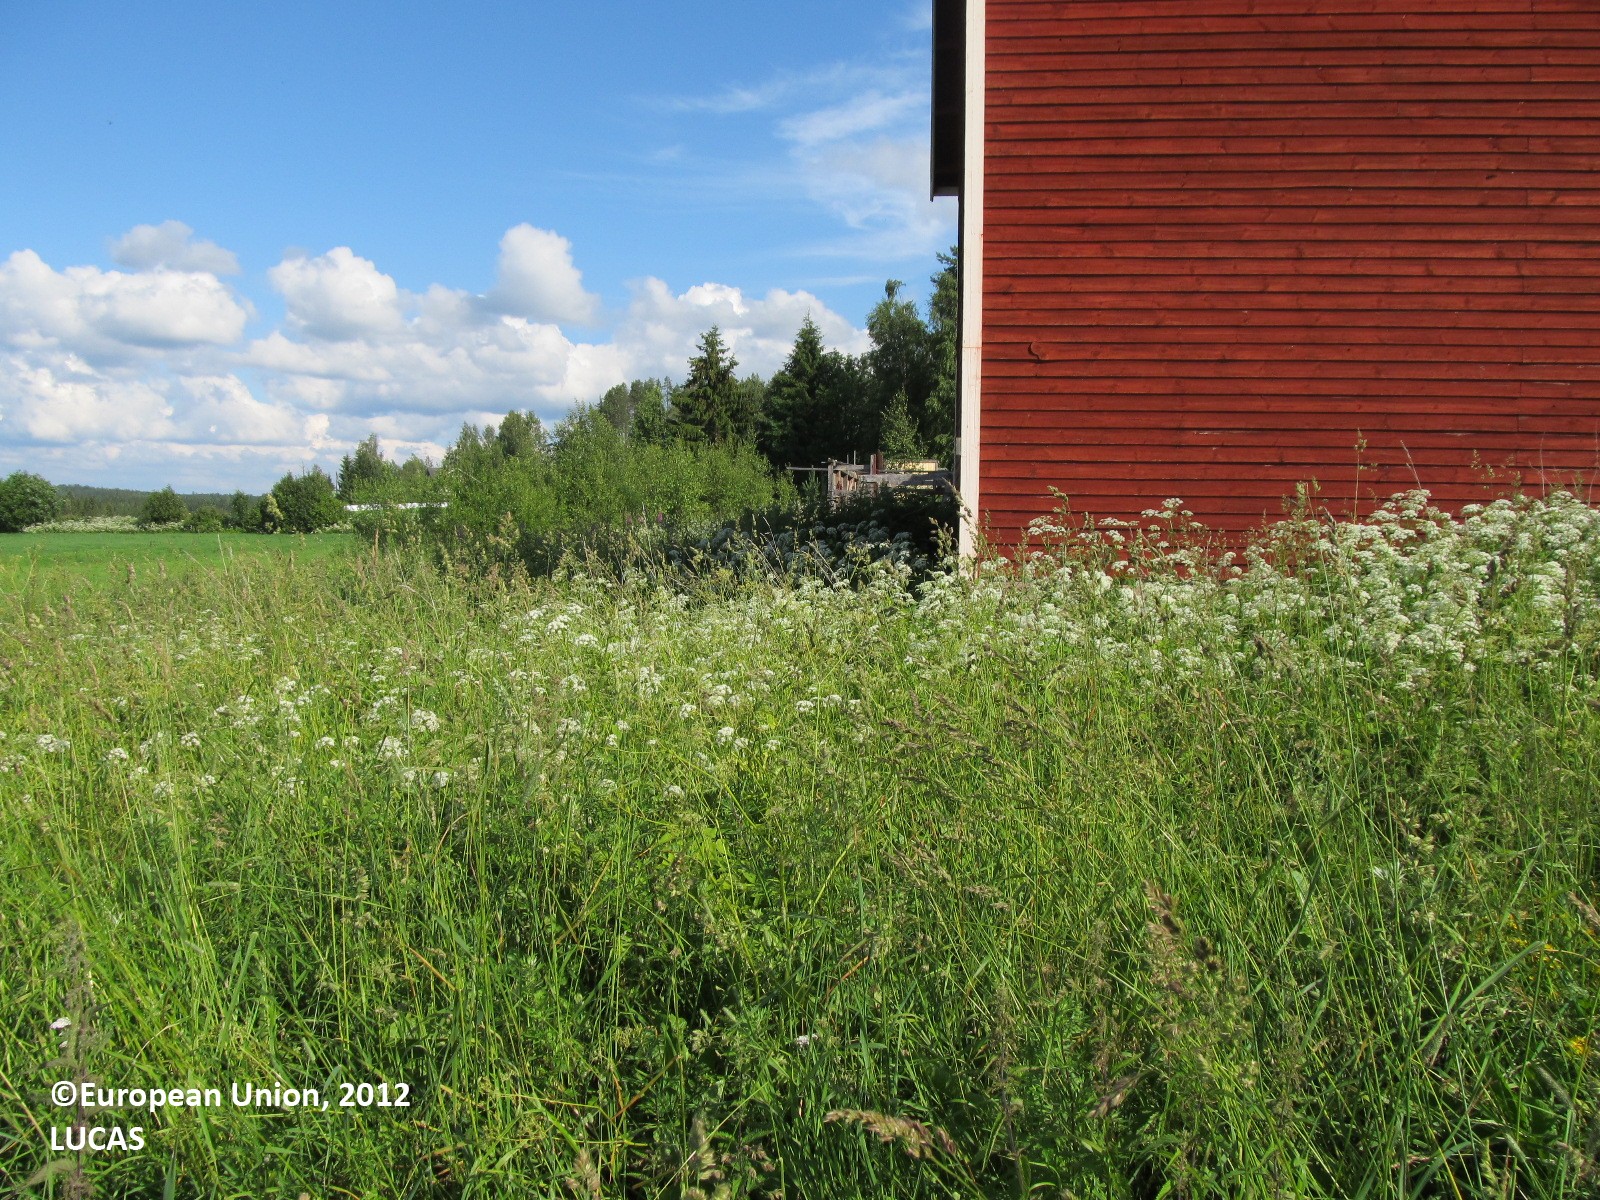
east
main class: Cropland
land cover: Barley
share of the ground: 50 - 75 %
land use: Agriculture (excluding fallow land and kitchen gardens)
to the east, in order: Barley; Abandoned hedges; Ditches and canals; Abandoned hedges; Barley
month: July
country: FI
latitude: 61.9576
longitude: 28.4528
